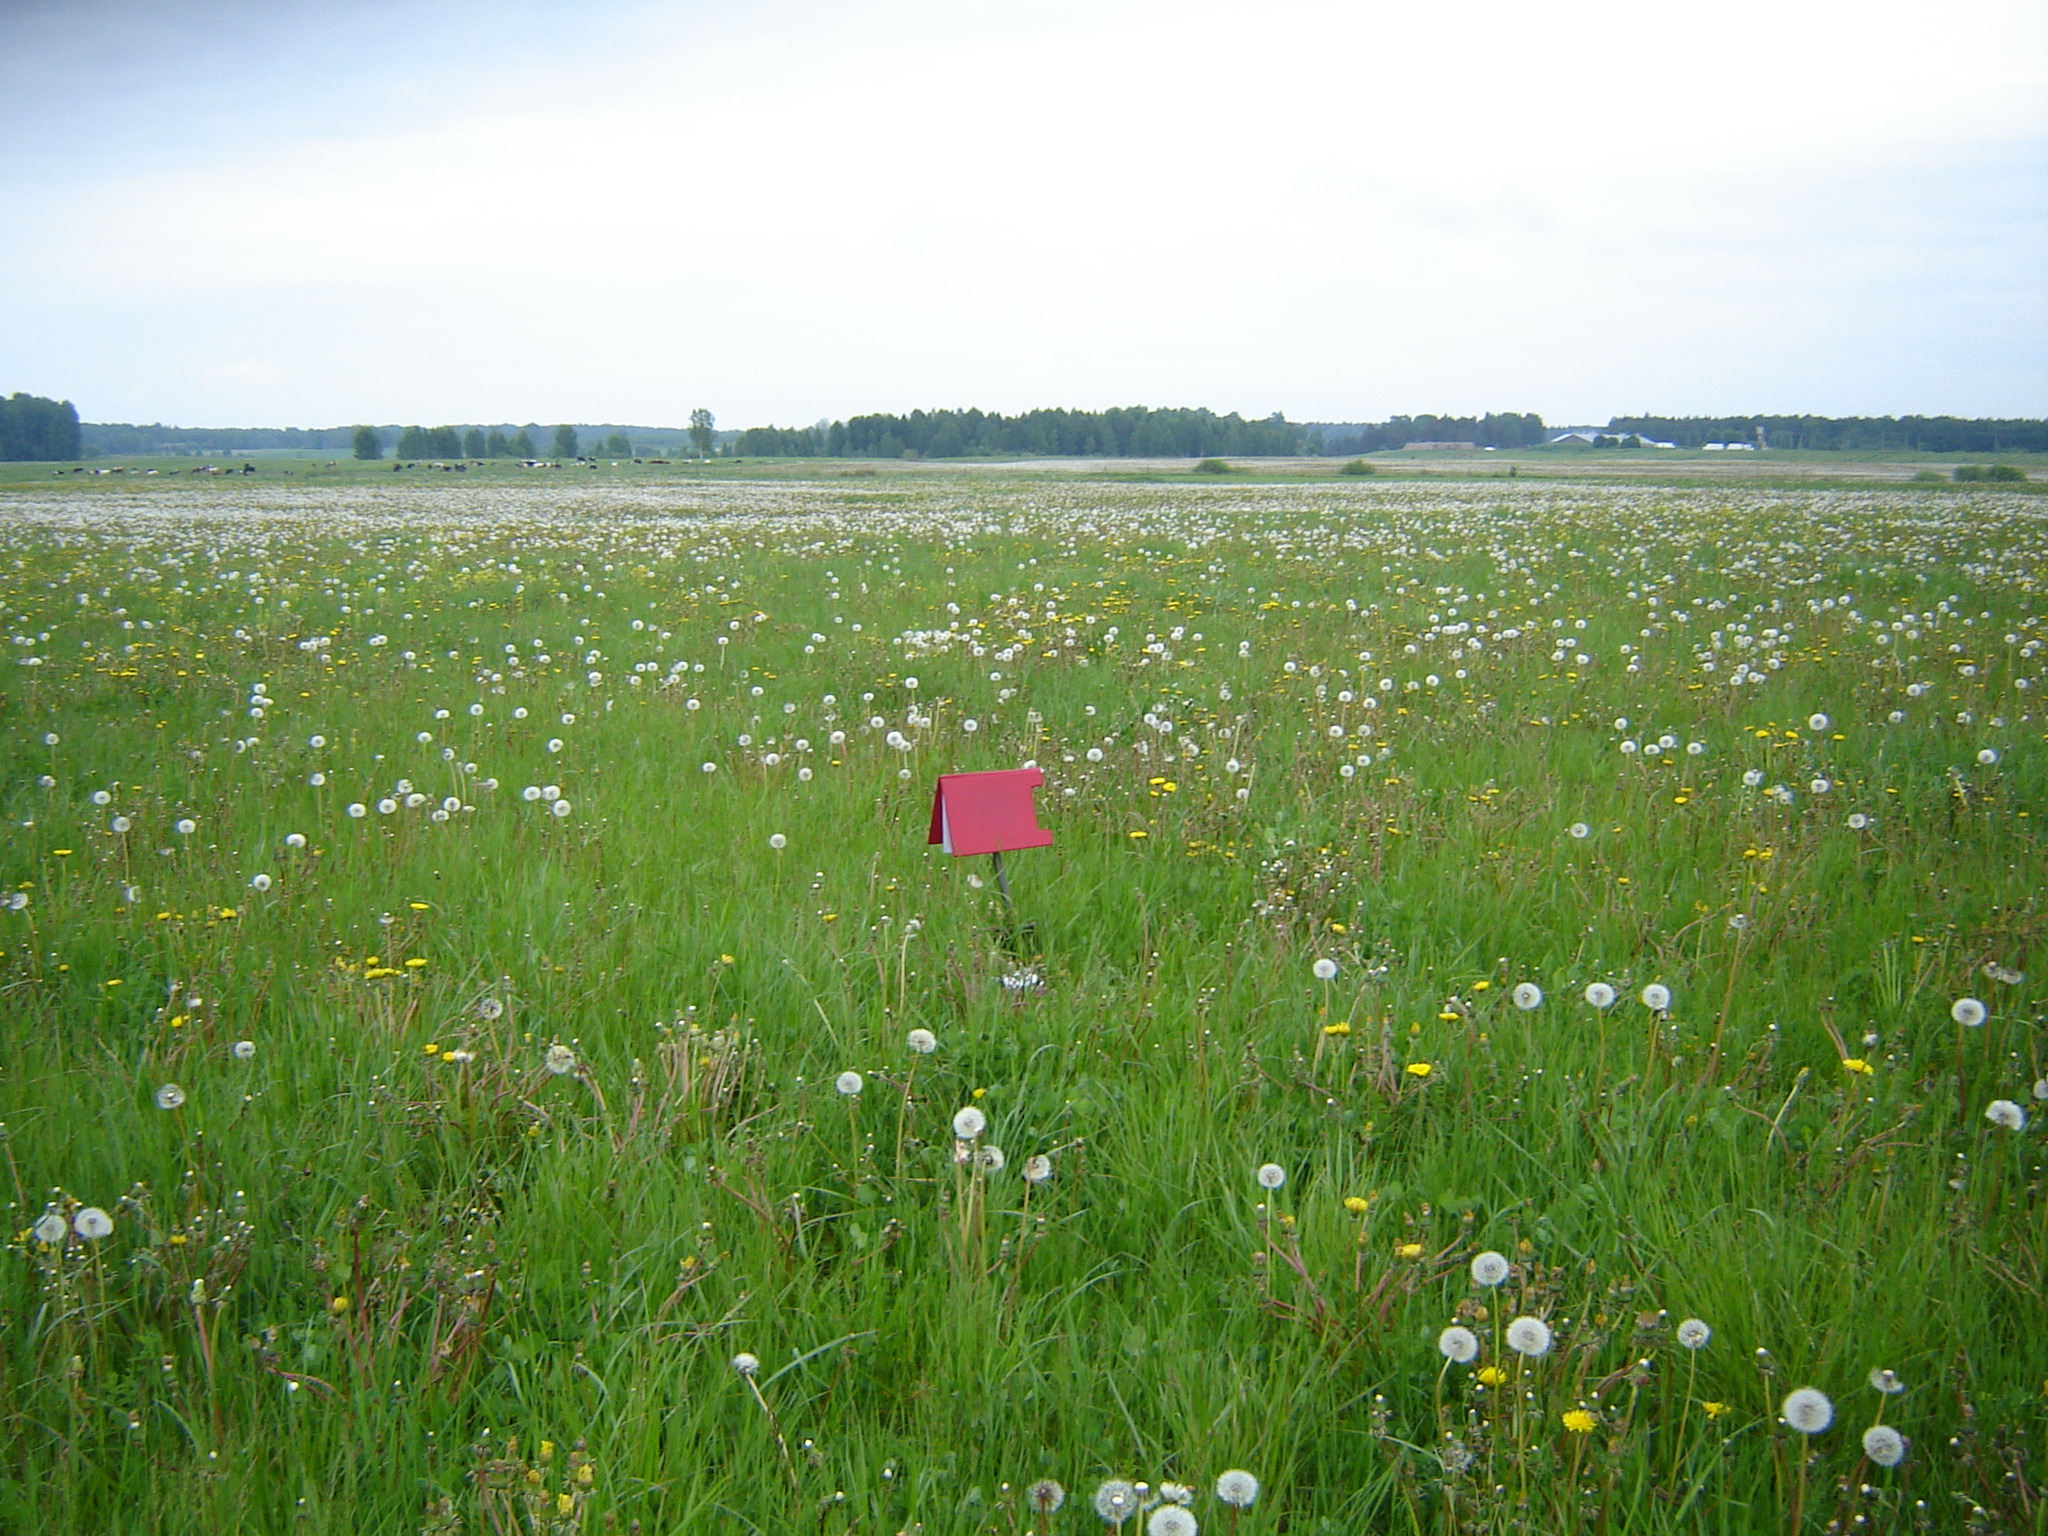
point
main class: Grassland
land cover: Grassland without tree/shrub cover
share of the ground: > 75 %
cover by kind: herbaceous plants 100 %
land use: Agriculture (excluding fallow land and kitchen gardens)
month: May
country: LT
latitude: 55.9958
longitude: 25.3006
